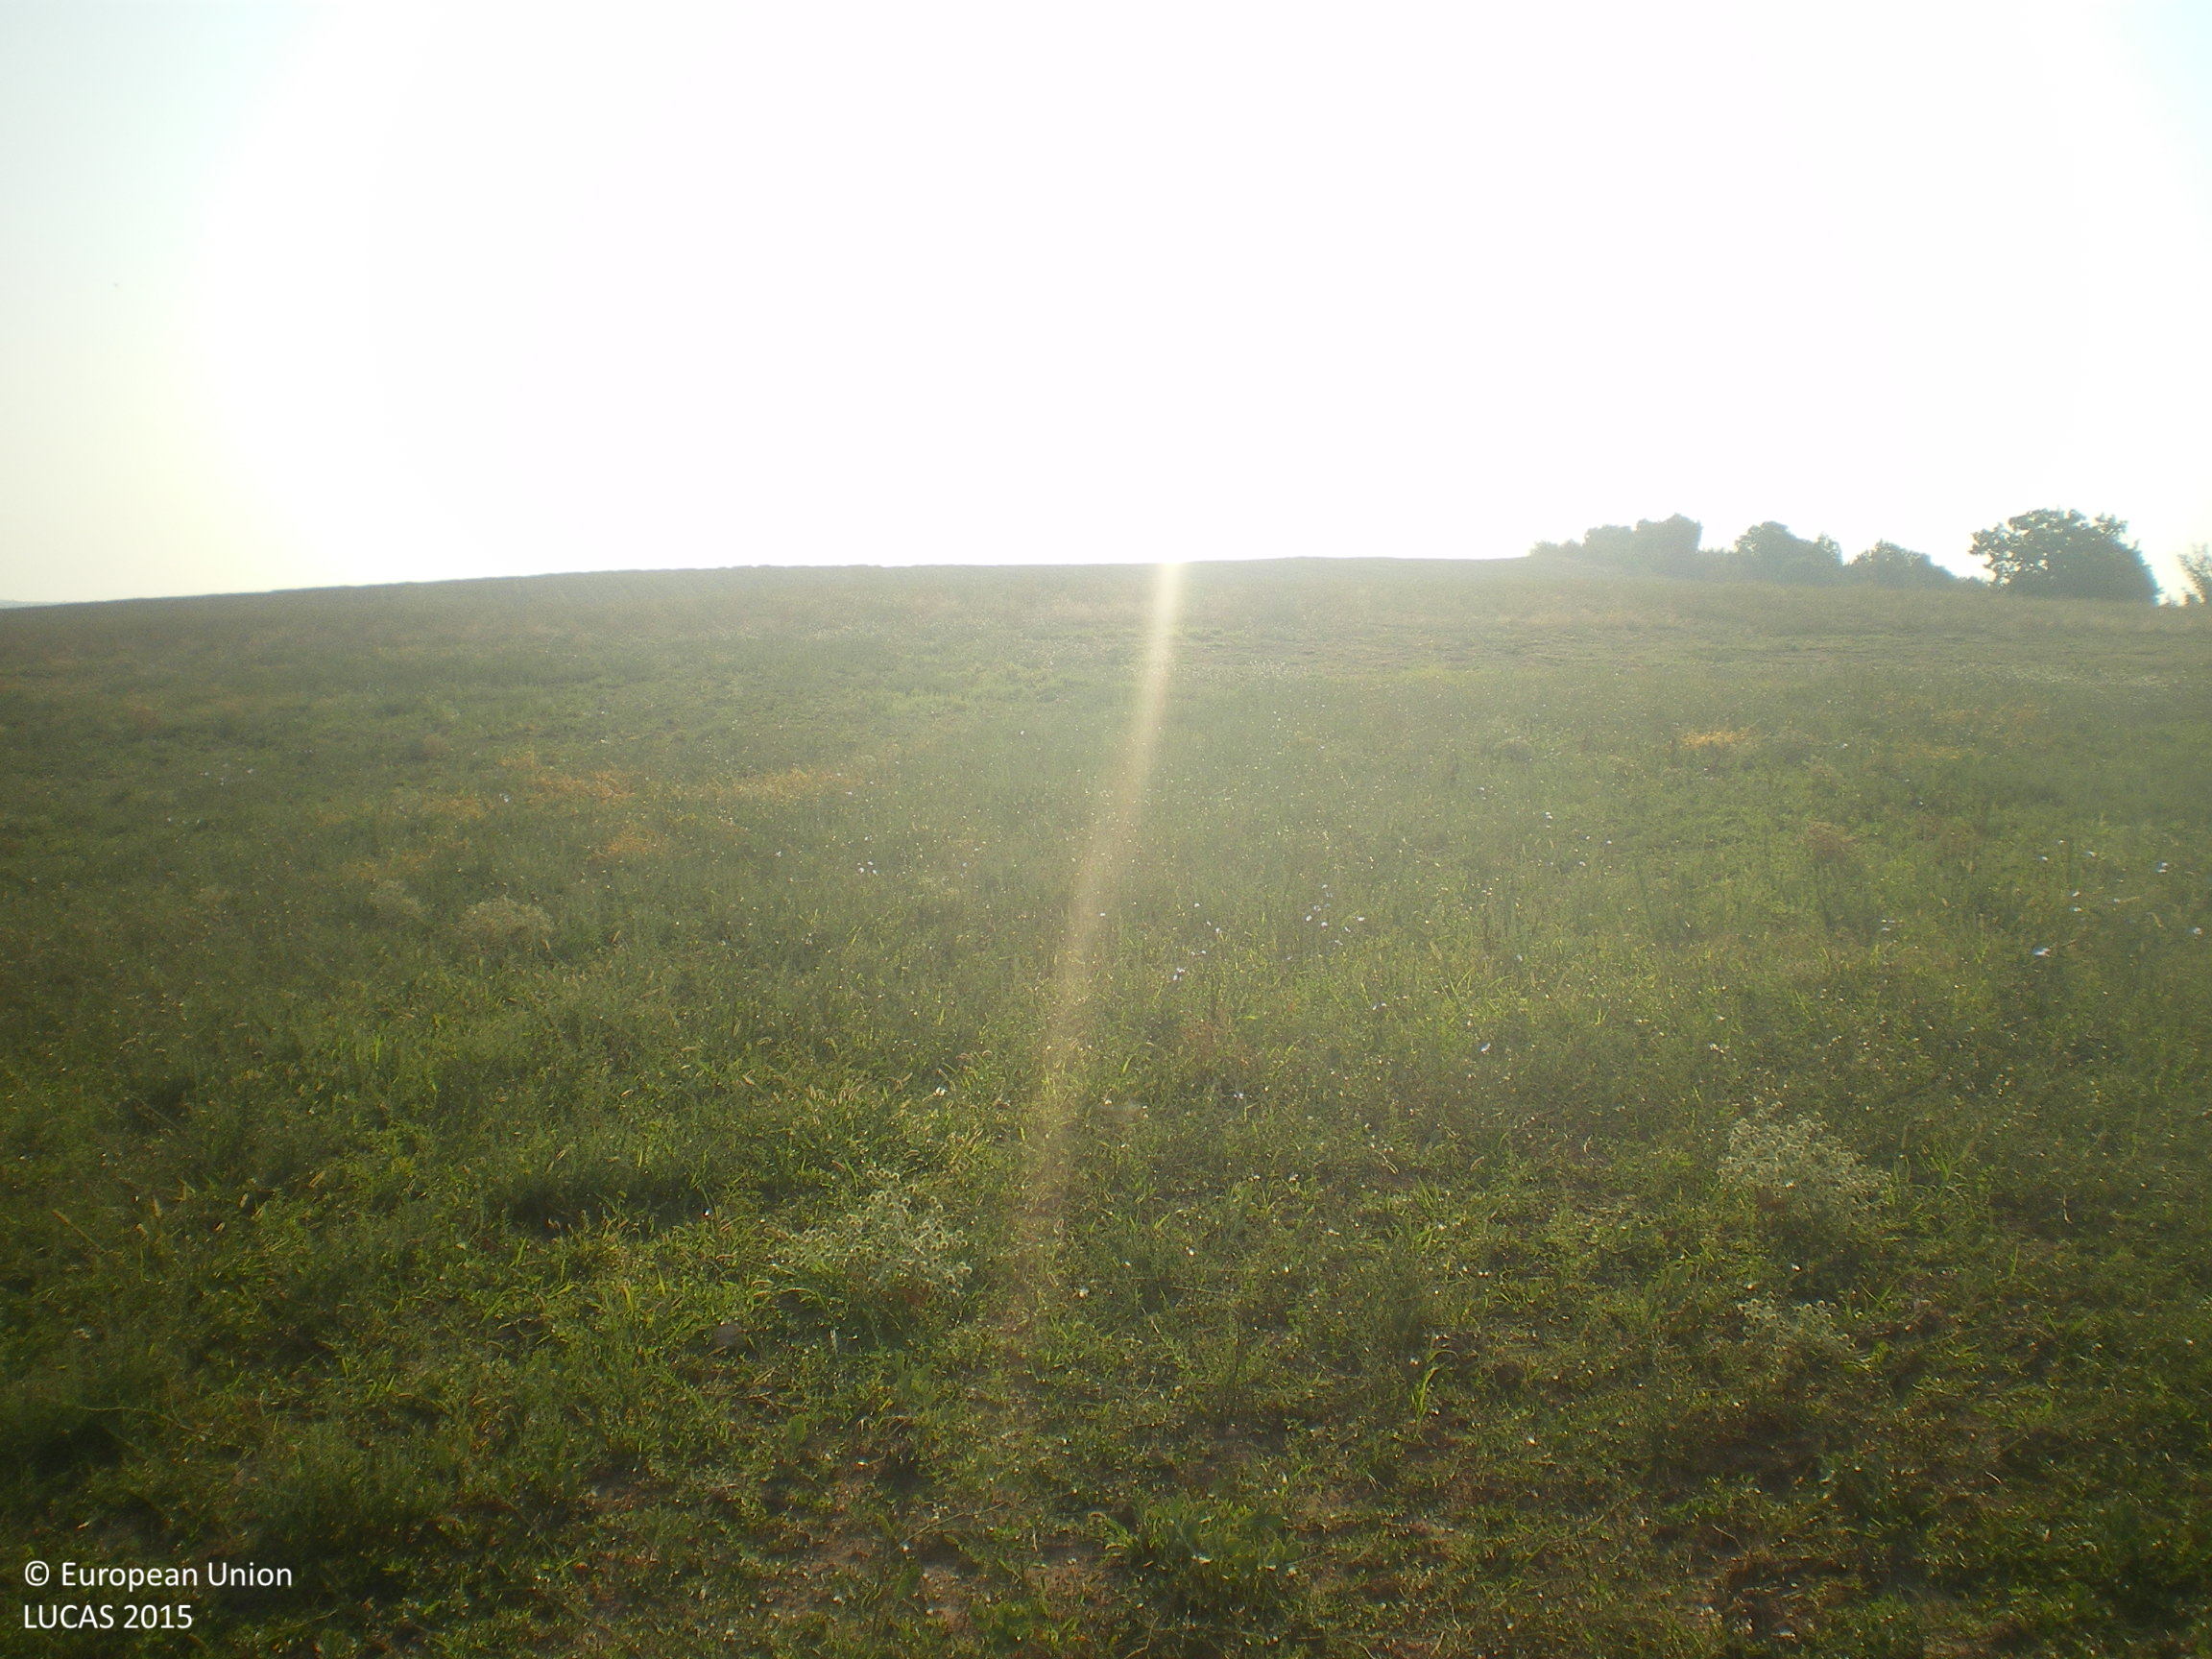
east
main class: Grassland
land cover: Grassland without tree/shrub cover
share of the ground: > 75 %
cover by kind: herbaceous plants 100 %
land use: Agriculture (excluding fallow land and kitchen gardens)
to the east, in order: Grassland without tree/shrub cover; Spontaneously vegetated surfaces; Common wheat
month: August
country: BG
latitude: 42.0128
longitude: 25.9031
